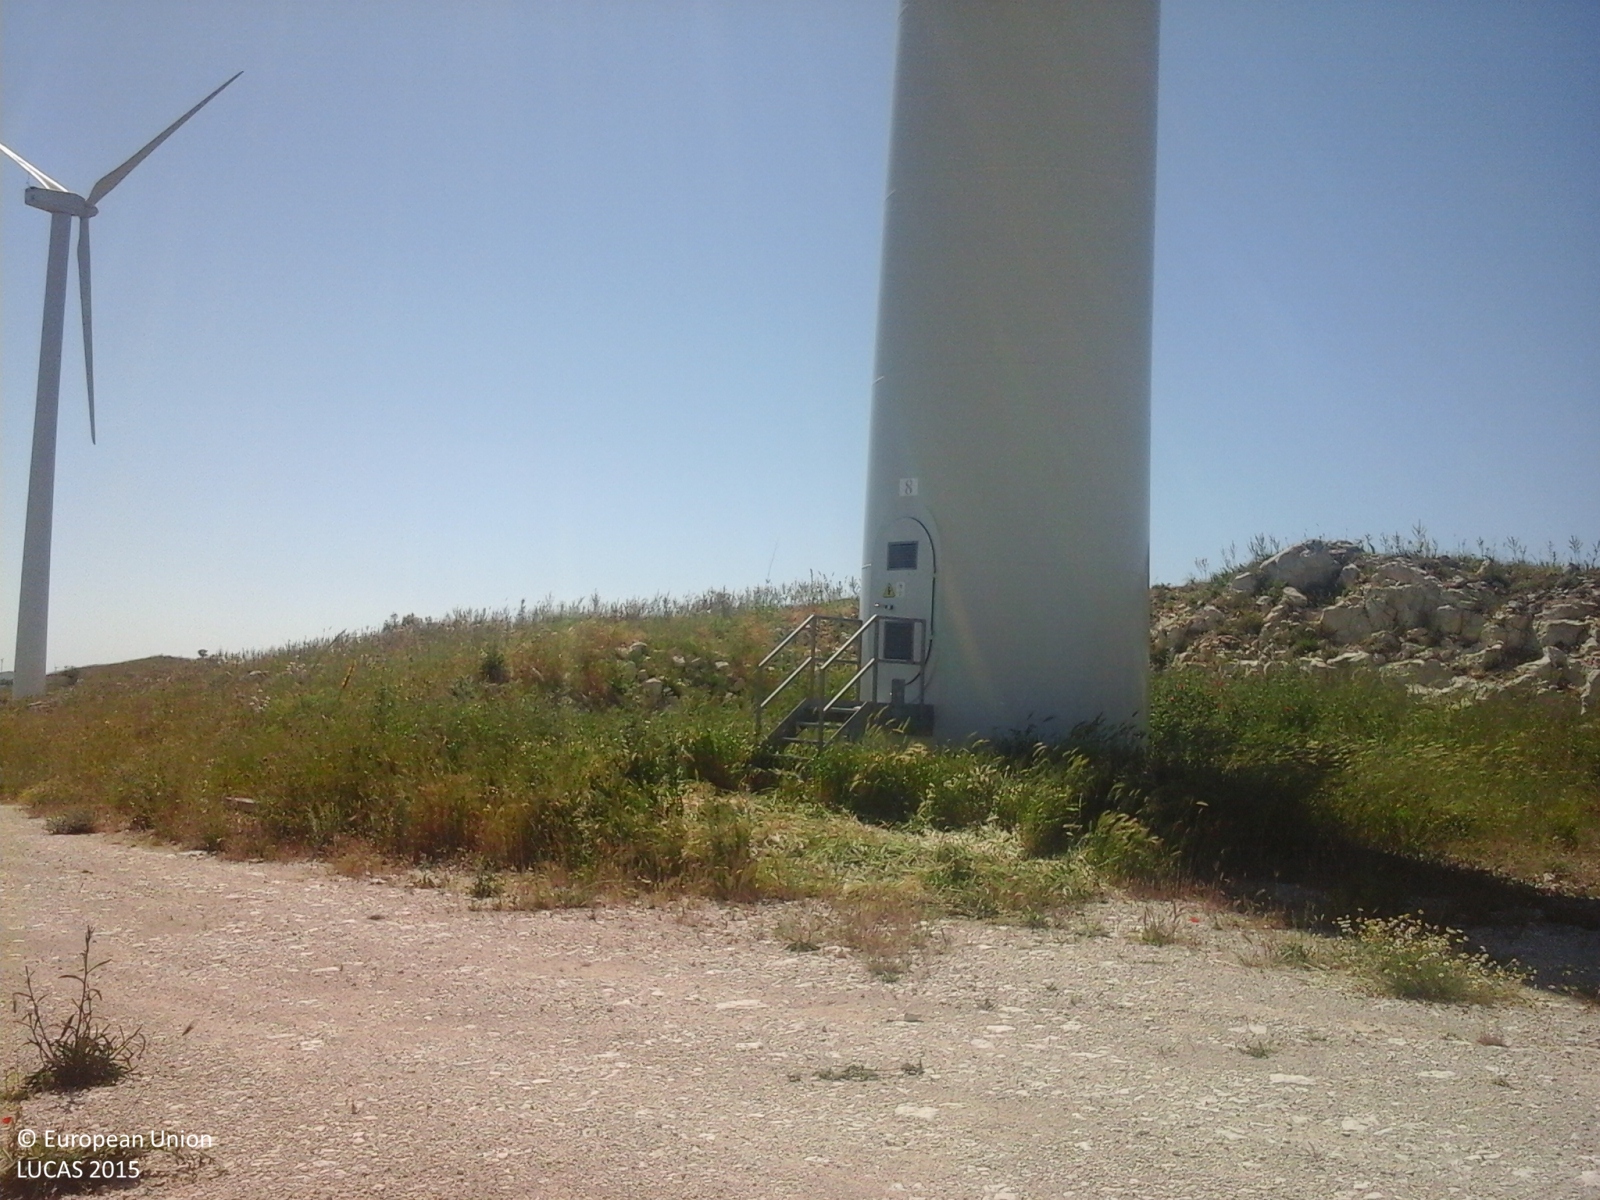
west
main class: Cropland
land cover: Durum wheat
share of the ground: > 75 %
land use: Agriculture (excluding fallow land and kitchen gardens)
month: May
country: IT
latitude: 37.6273
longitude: 13.9931
